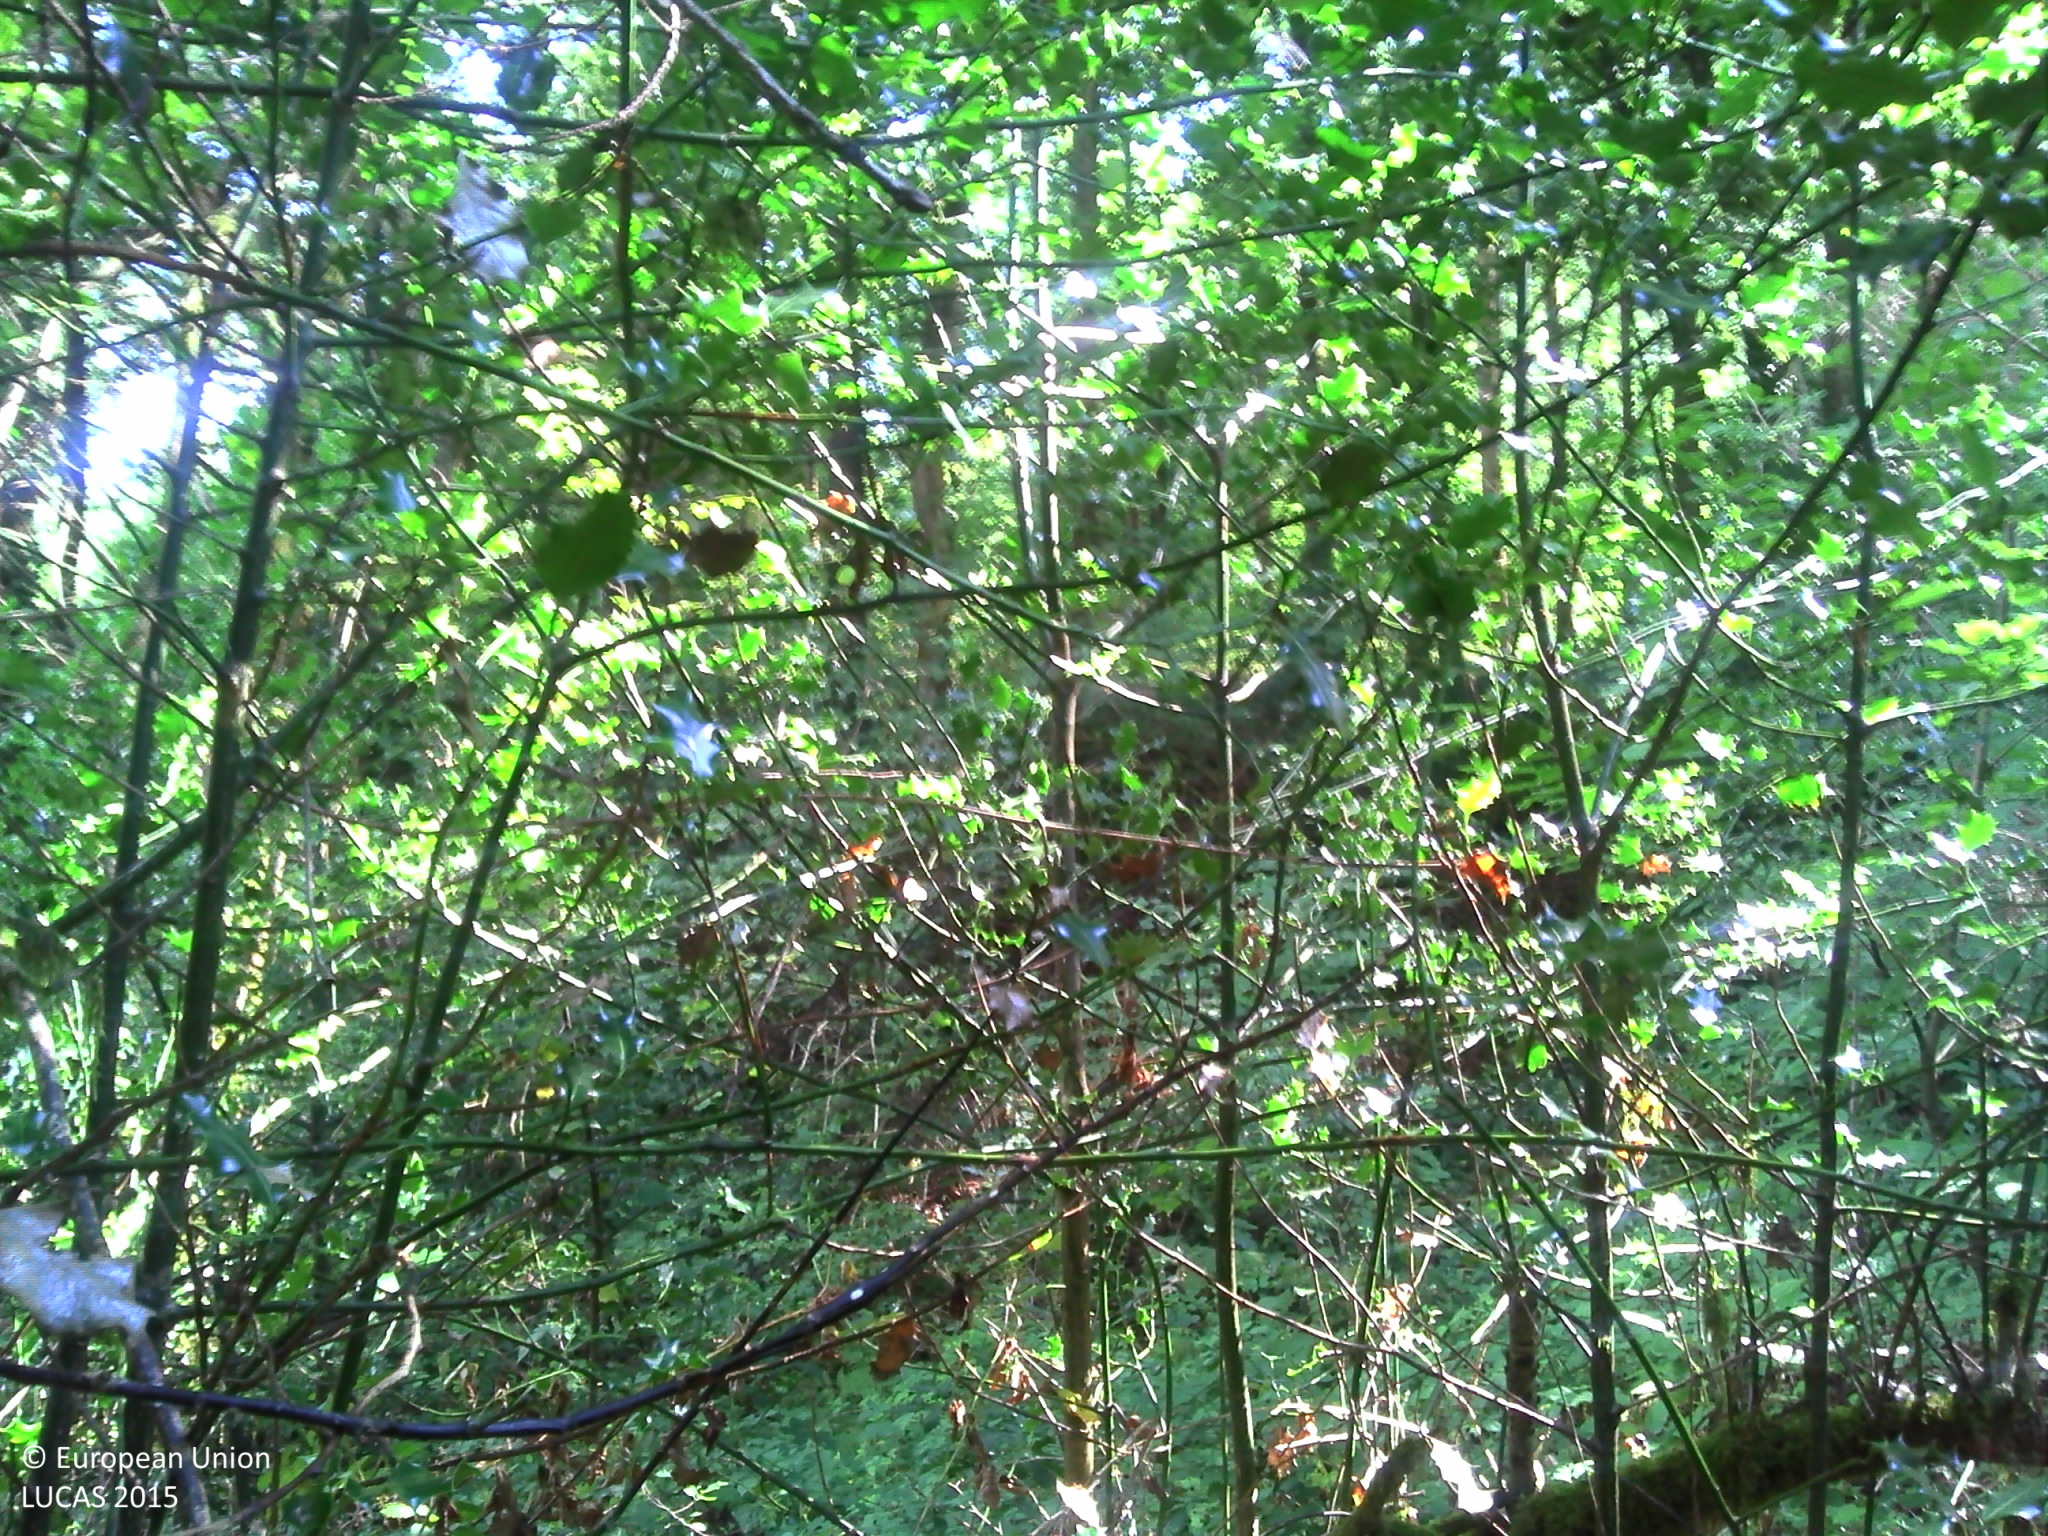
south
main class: Woodland
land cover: Spruce dominated mixed woodland
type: mesophytic deciduous forest
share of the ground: > 75 %
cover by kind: broadleaved forest trees 40 %, coniferous forest trees 25 %, shrubs 25 %, herbaceous plants 5 %, lichens and mosses 5 %
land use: Forestry
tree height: > 5 m
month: August
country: FR
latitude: 45.9734
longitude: 1.6941
